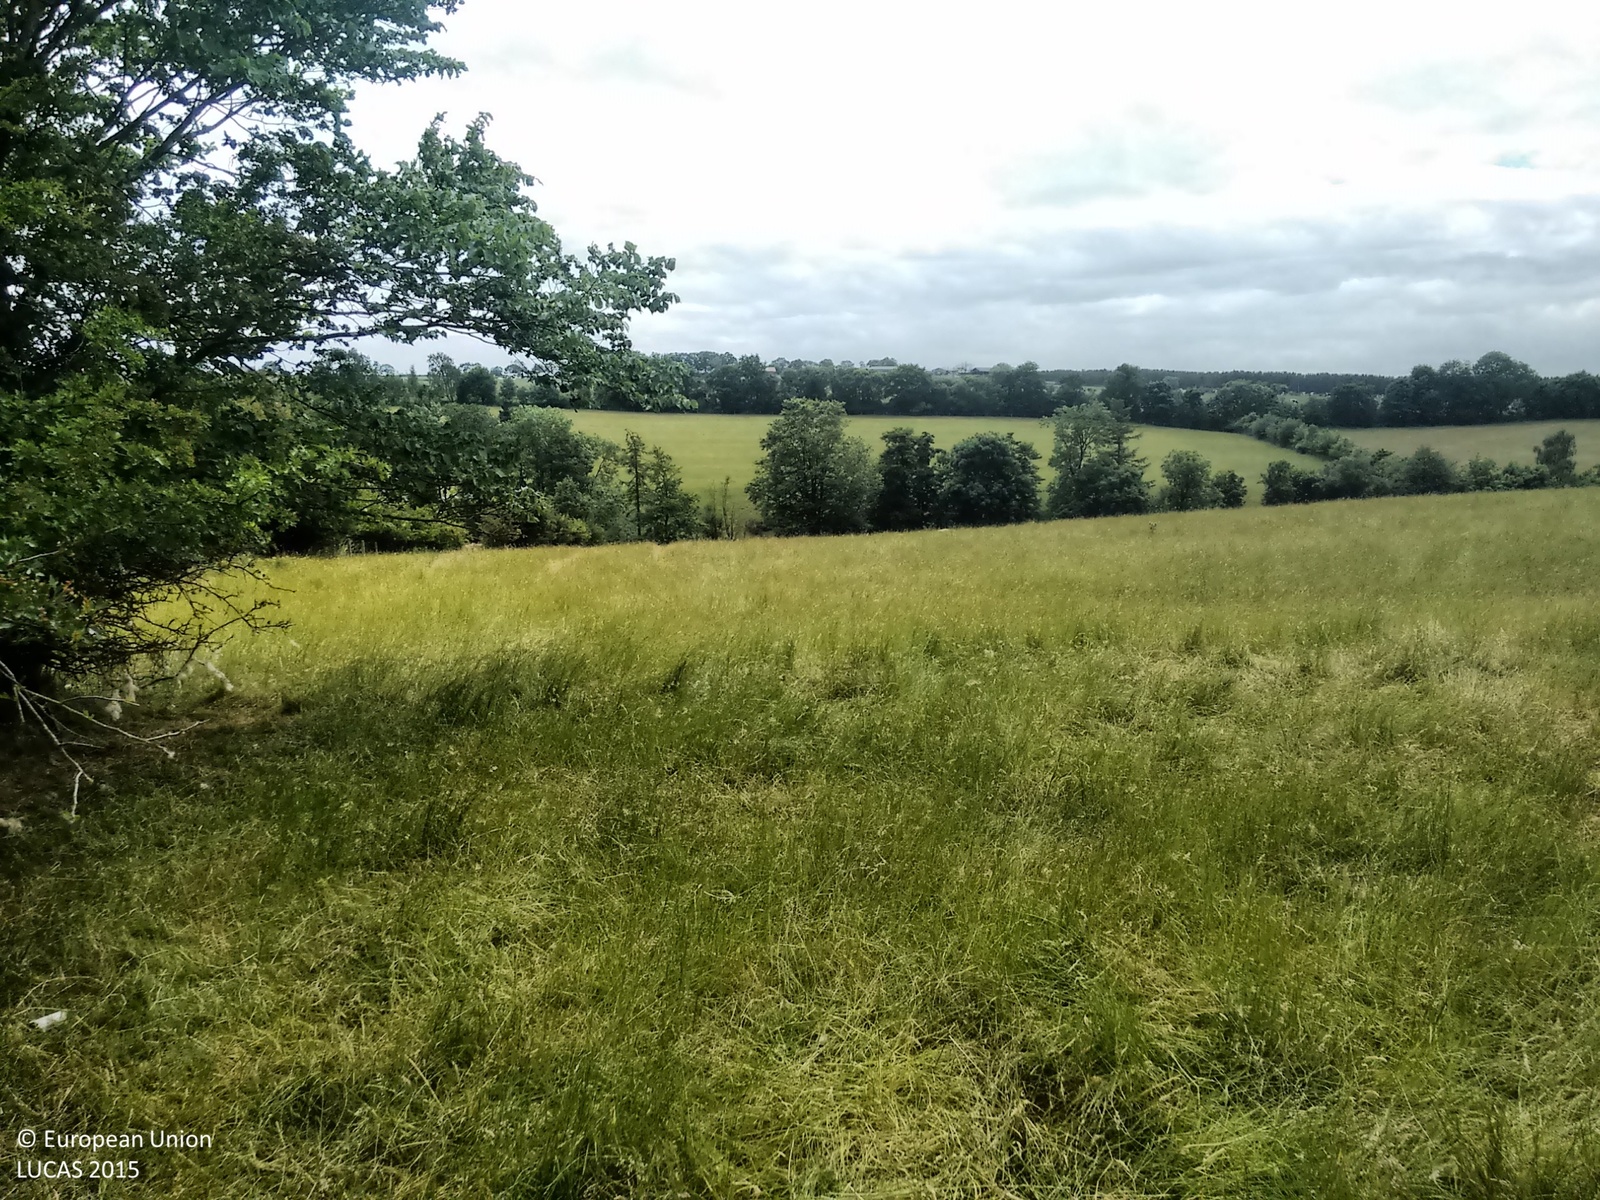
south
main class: Grassland
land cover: Grassland without tree/shrub cover
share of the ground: > 75 %
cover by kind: herbaceous plants 100 %
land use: Agriculture (excluding fallow land and kitchen gardens)
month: June
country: GB
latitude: 54.6984
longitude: -1.7670
